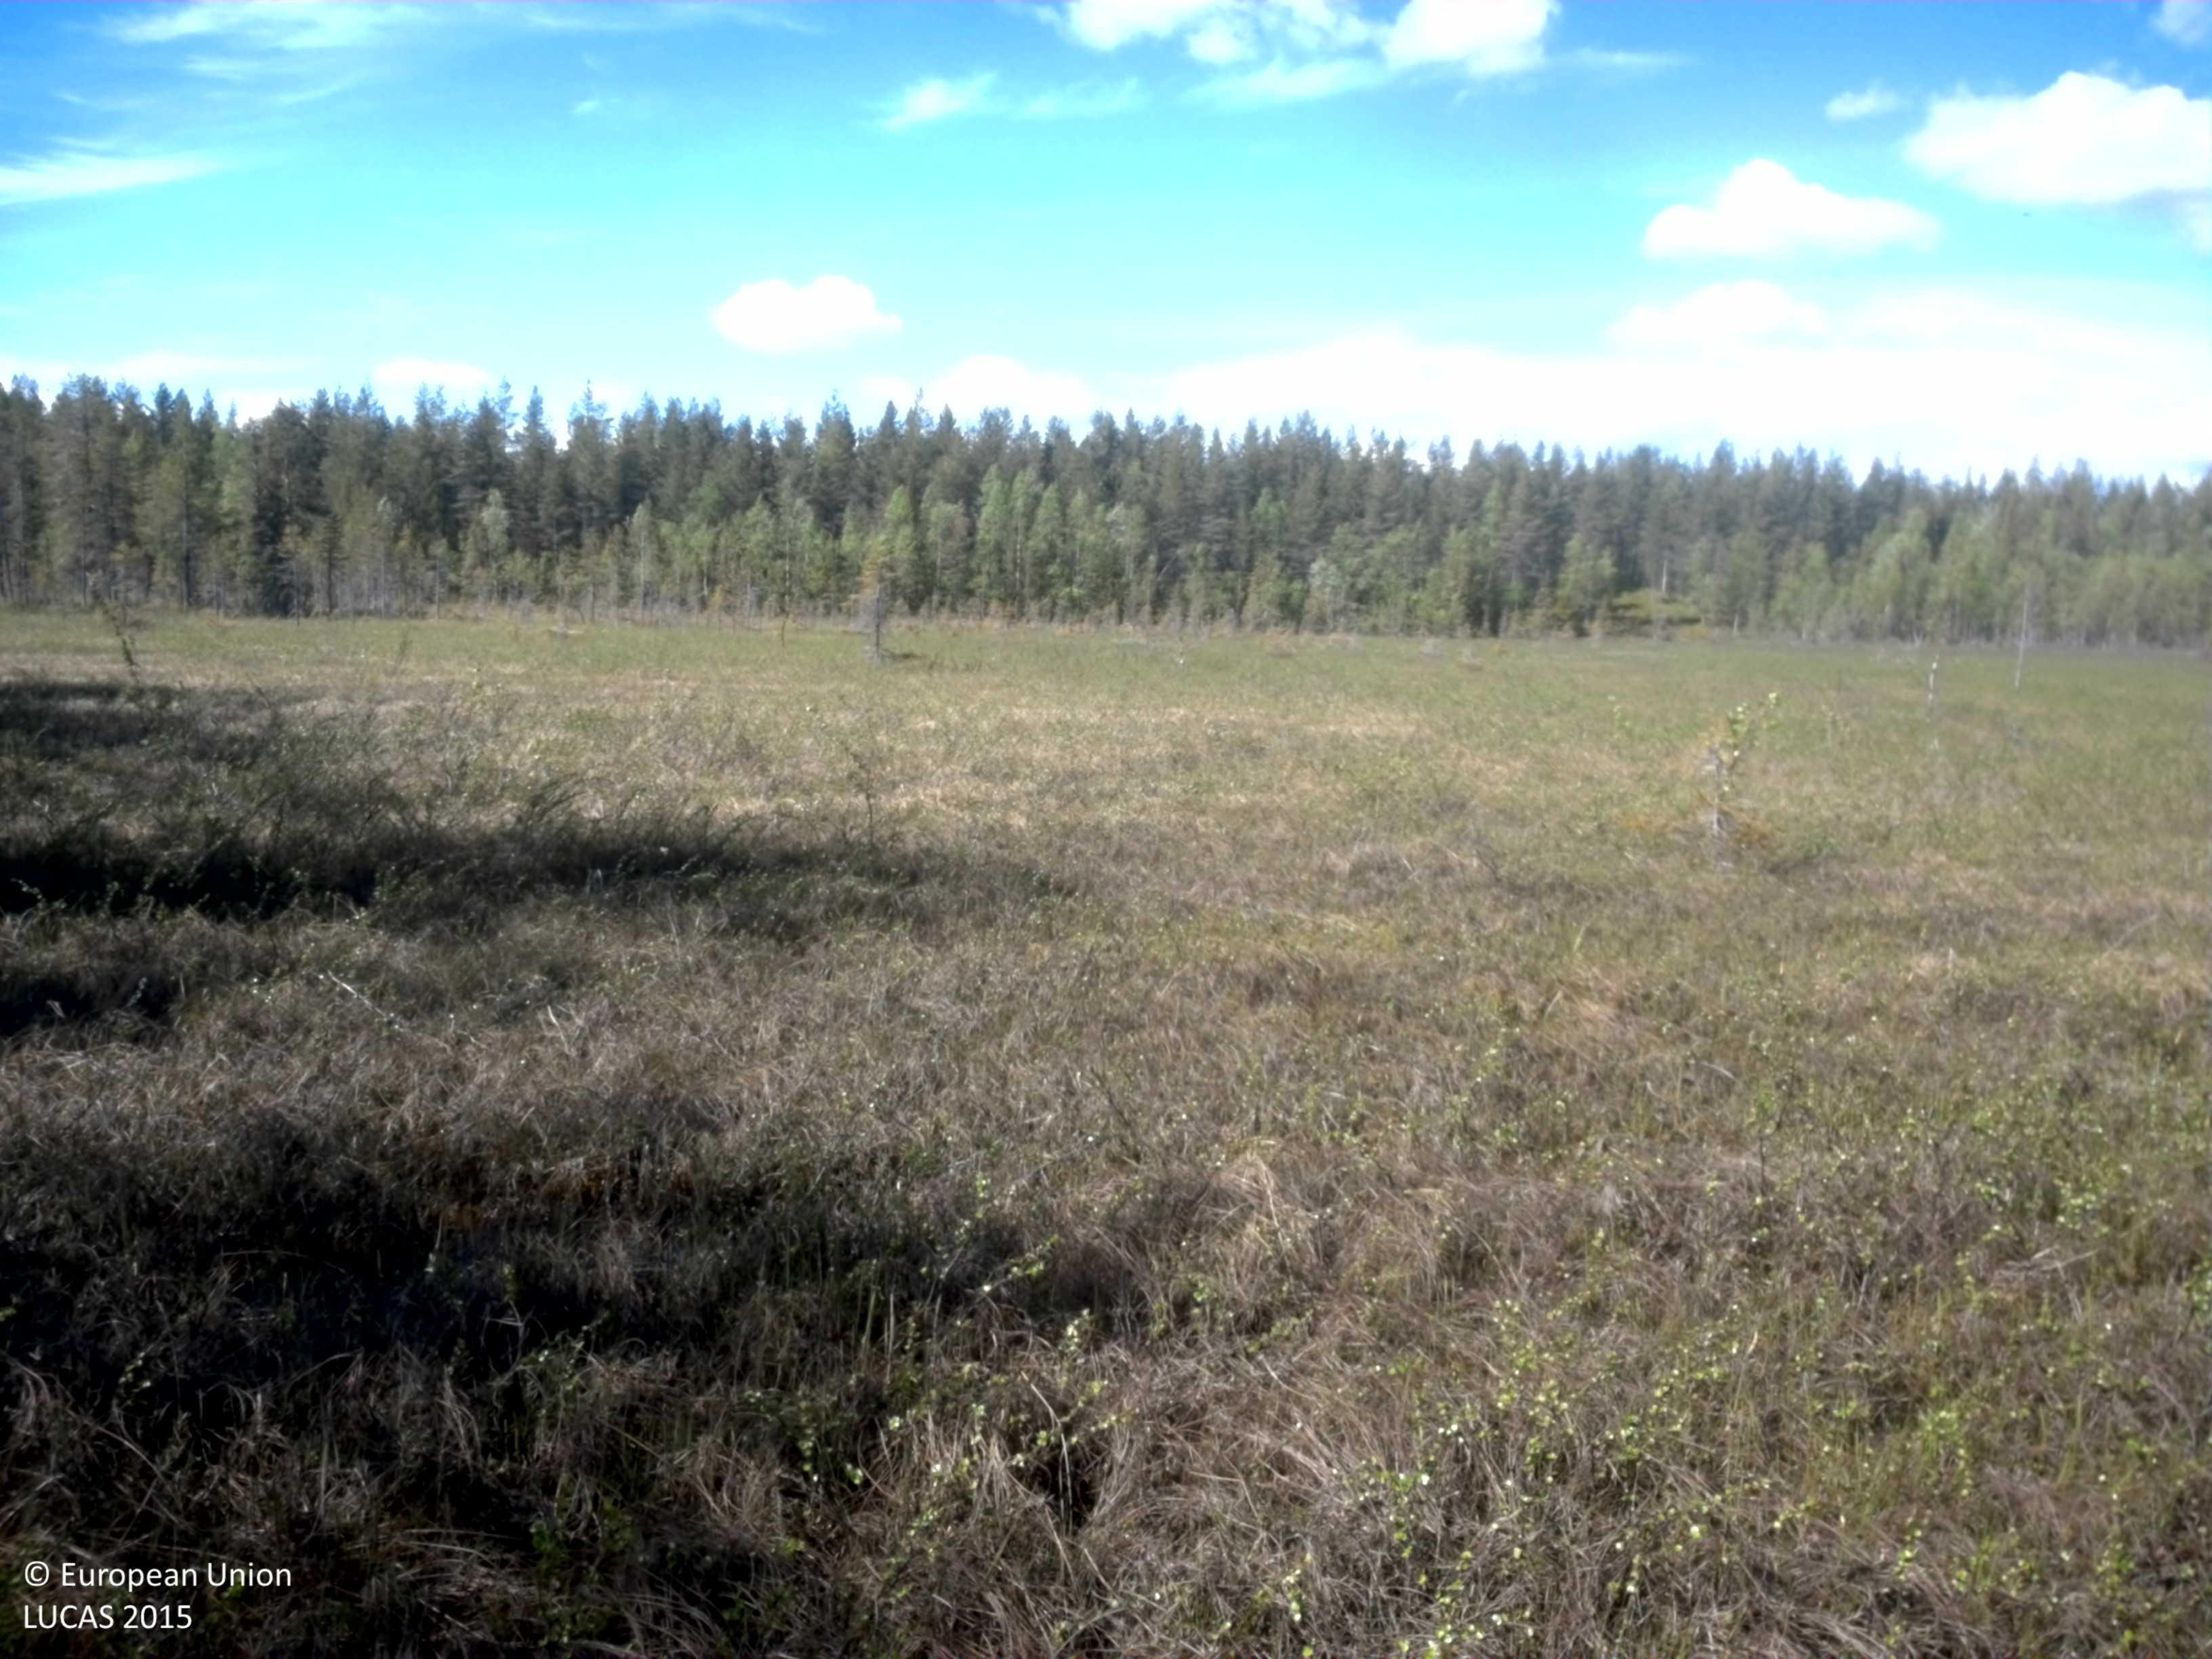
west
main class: Shrubland
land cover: Shrubland with sparse tree cover
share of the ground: 50 - 75 %
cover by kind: shrubs 50 %, herbaceous plants 45 %, broadleaved forest trees 5 %
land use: Semi-natural and natural areas not in use
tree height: < 5 m
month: June
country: SE
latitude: 67.1823
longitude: 21.2519
